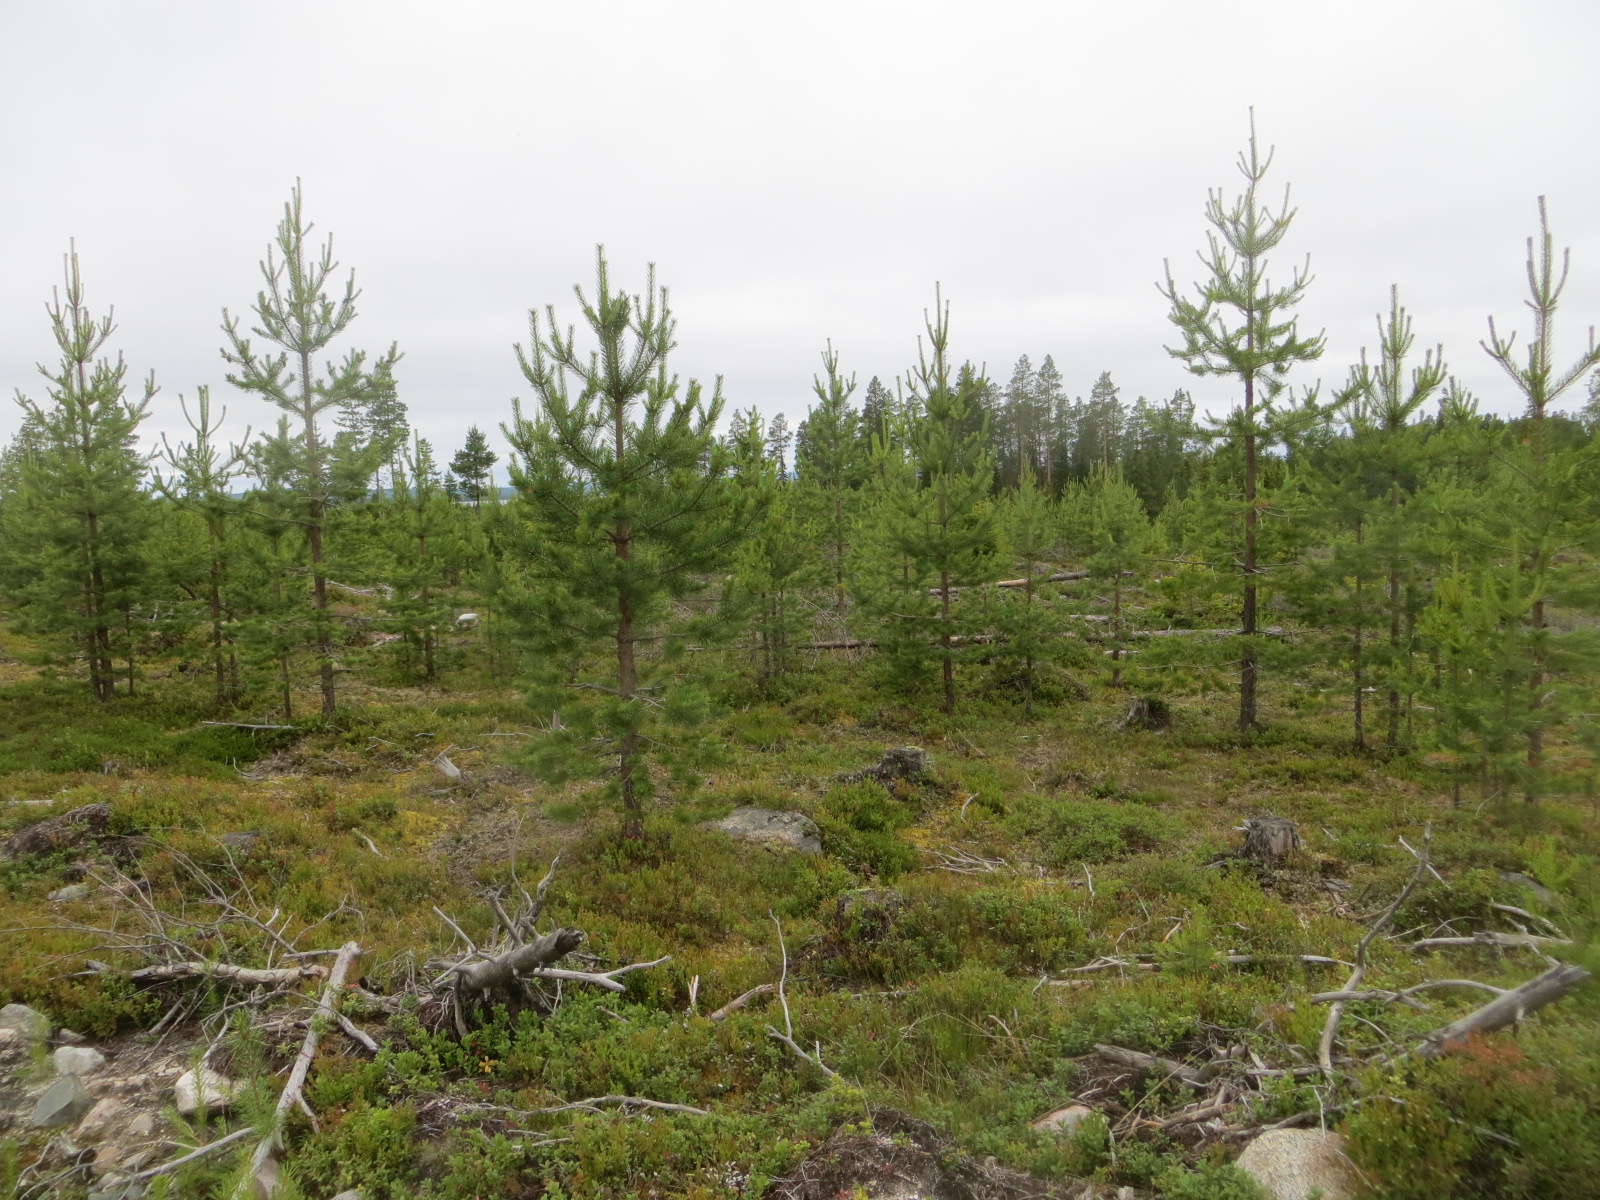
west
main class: Woodland
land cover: Pine dominated coniferous woodland
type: boreal forest
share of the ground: 25 - 50 %
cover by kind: shrubs 70 %, coniferous forest trees 25 %, broadleaved forest trees 5 %
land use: Forestry
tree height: < 5 m
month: July
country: FI
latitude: 66.4296
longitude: 24.4093
